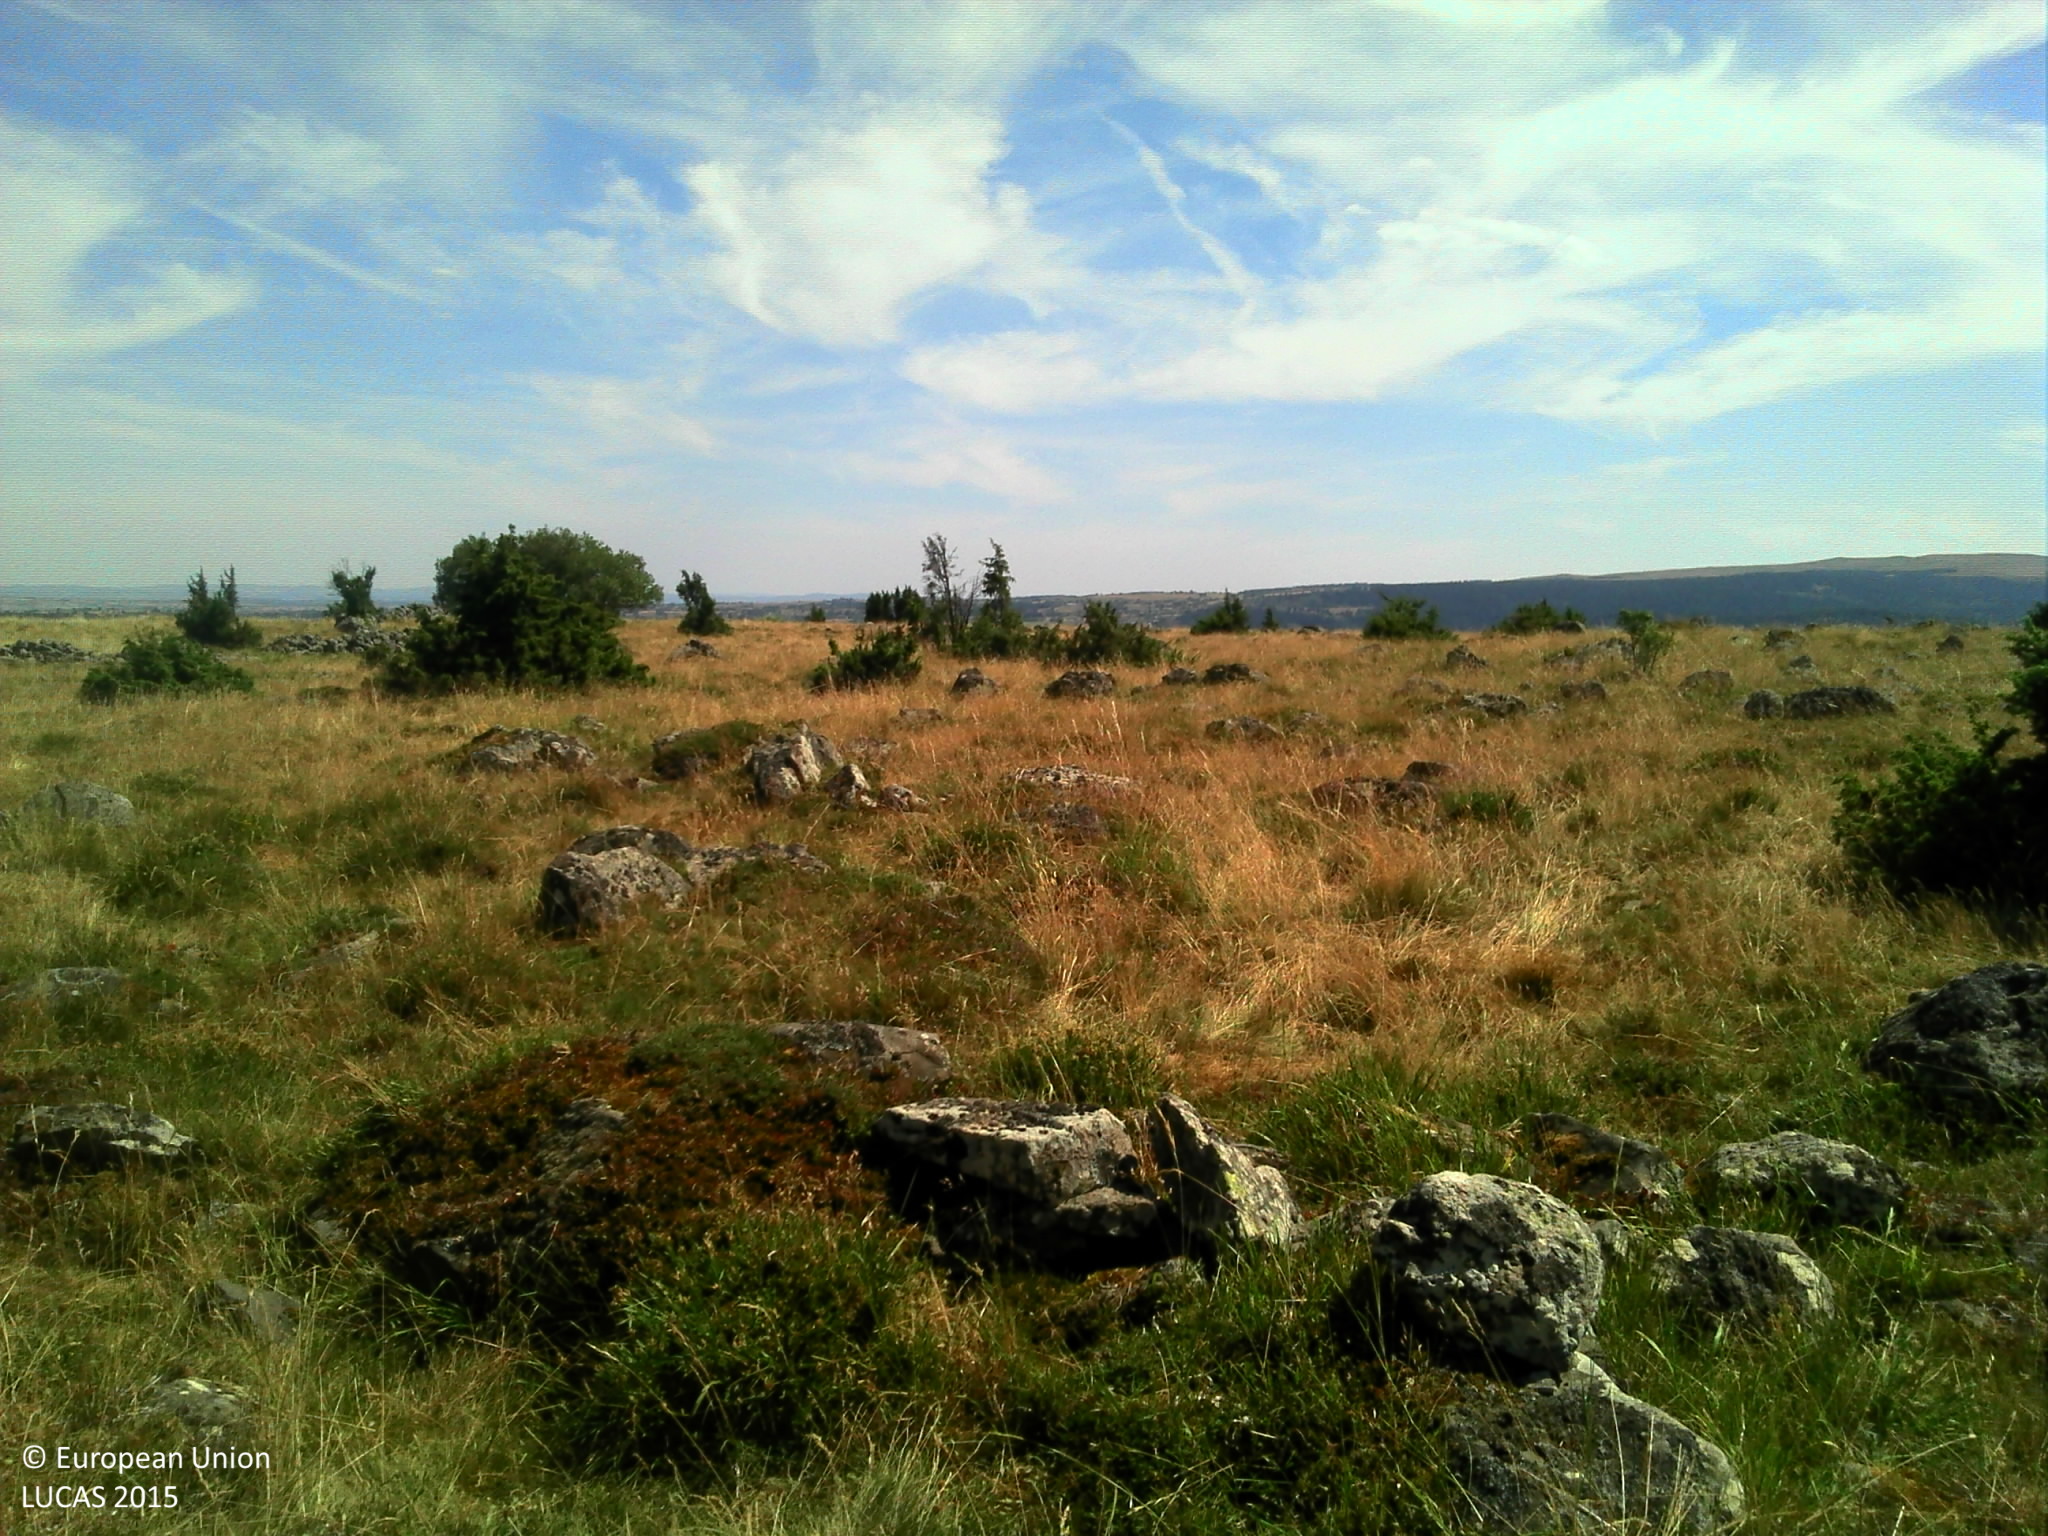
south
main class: Shrubland
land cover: Shrubland with sparse tree cover
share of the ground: > 75 %
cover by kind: herbaceous plants 70 %, shrubs 25 %, coniferous forest trees 5 %
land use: Agriculture (excluding fallow land and kitchen gardens)
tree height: < 5 m
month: July
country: FR
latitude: 45.1364
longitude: 2.8675
